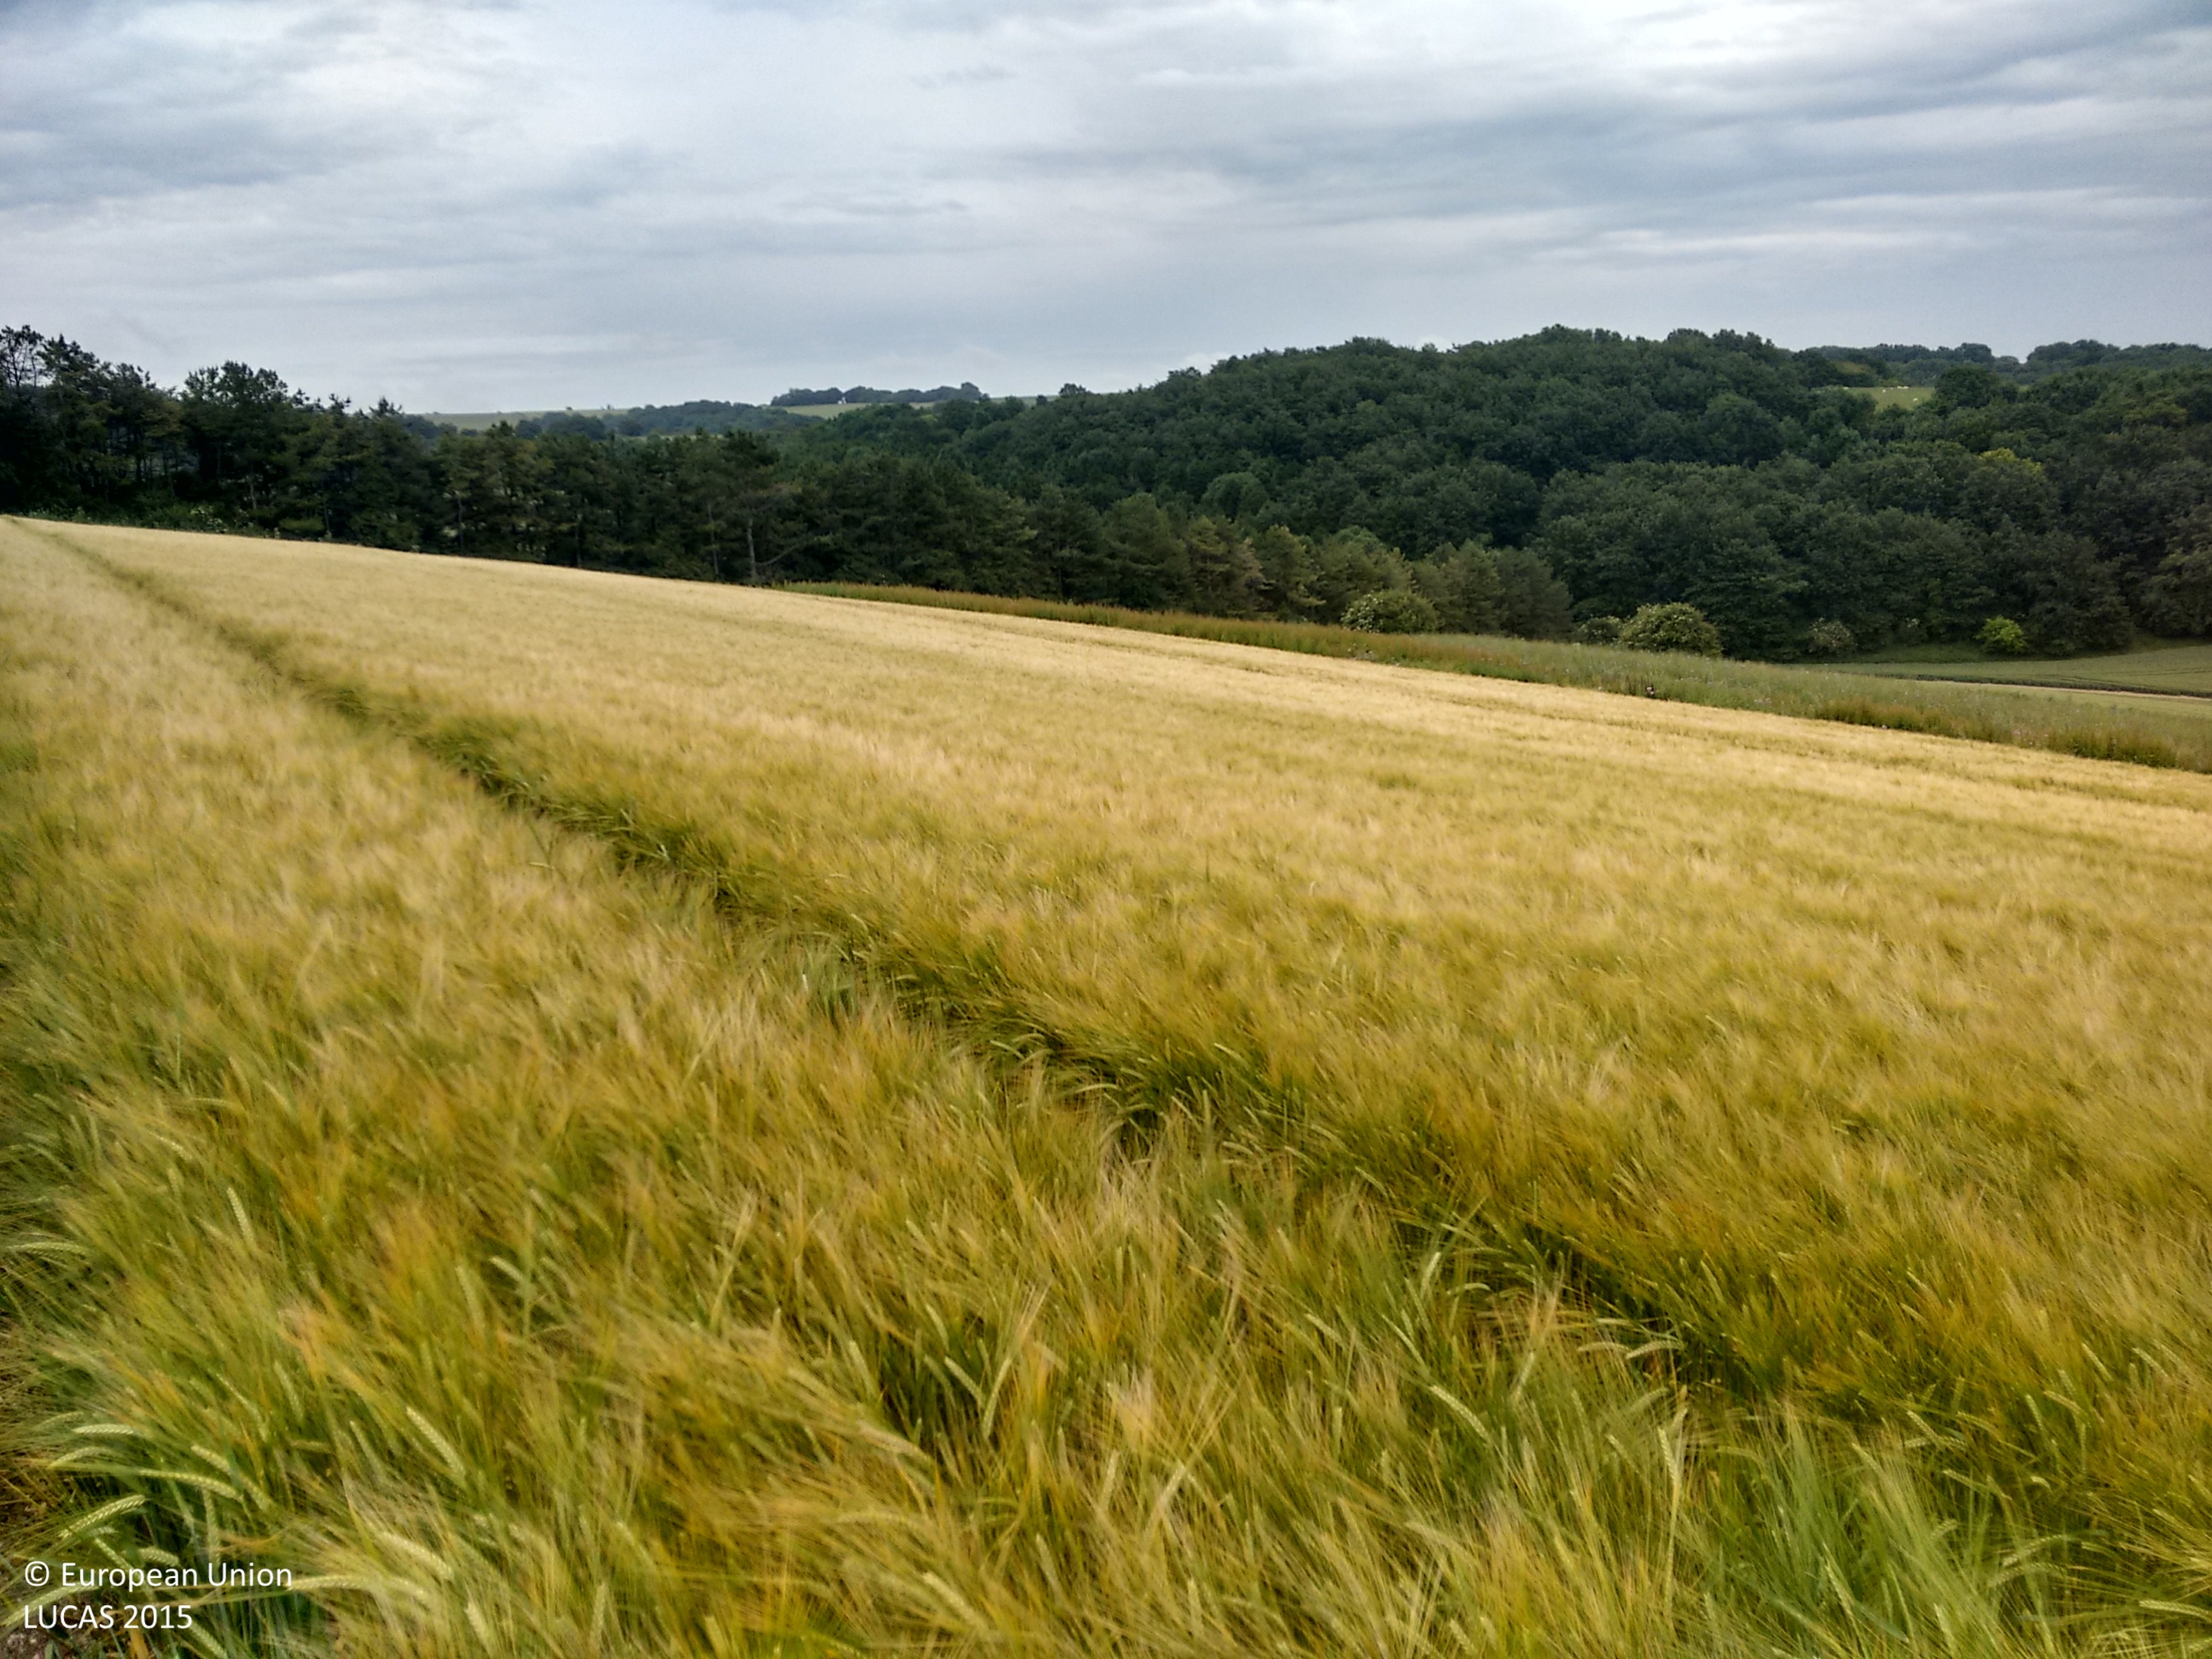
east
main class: Cropland
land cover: Barley
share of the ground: > 75 %
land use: Agriculture (excluding fallow land and kitchen gardens)
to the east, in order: Barley; Spontaneously vegetated surfaces; Fences; Shruby margins; Maize; Pine dominated coniferous woodland; Fences; Grassland without tree/shrub cover
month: July
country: GB
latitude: 50.8859
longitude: -0.3997
